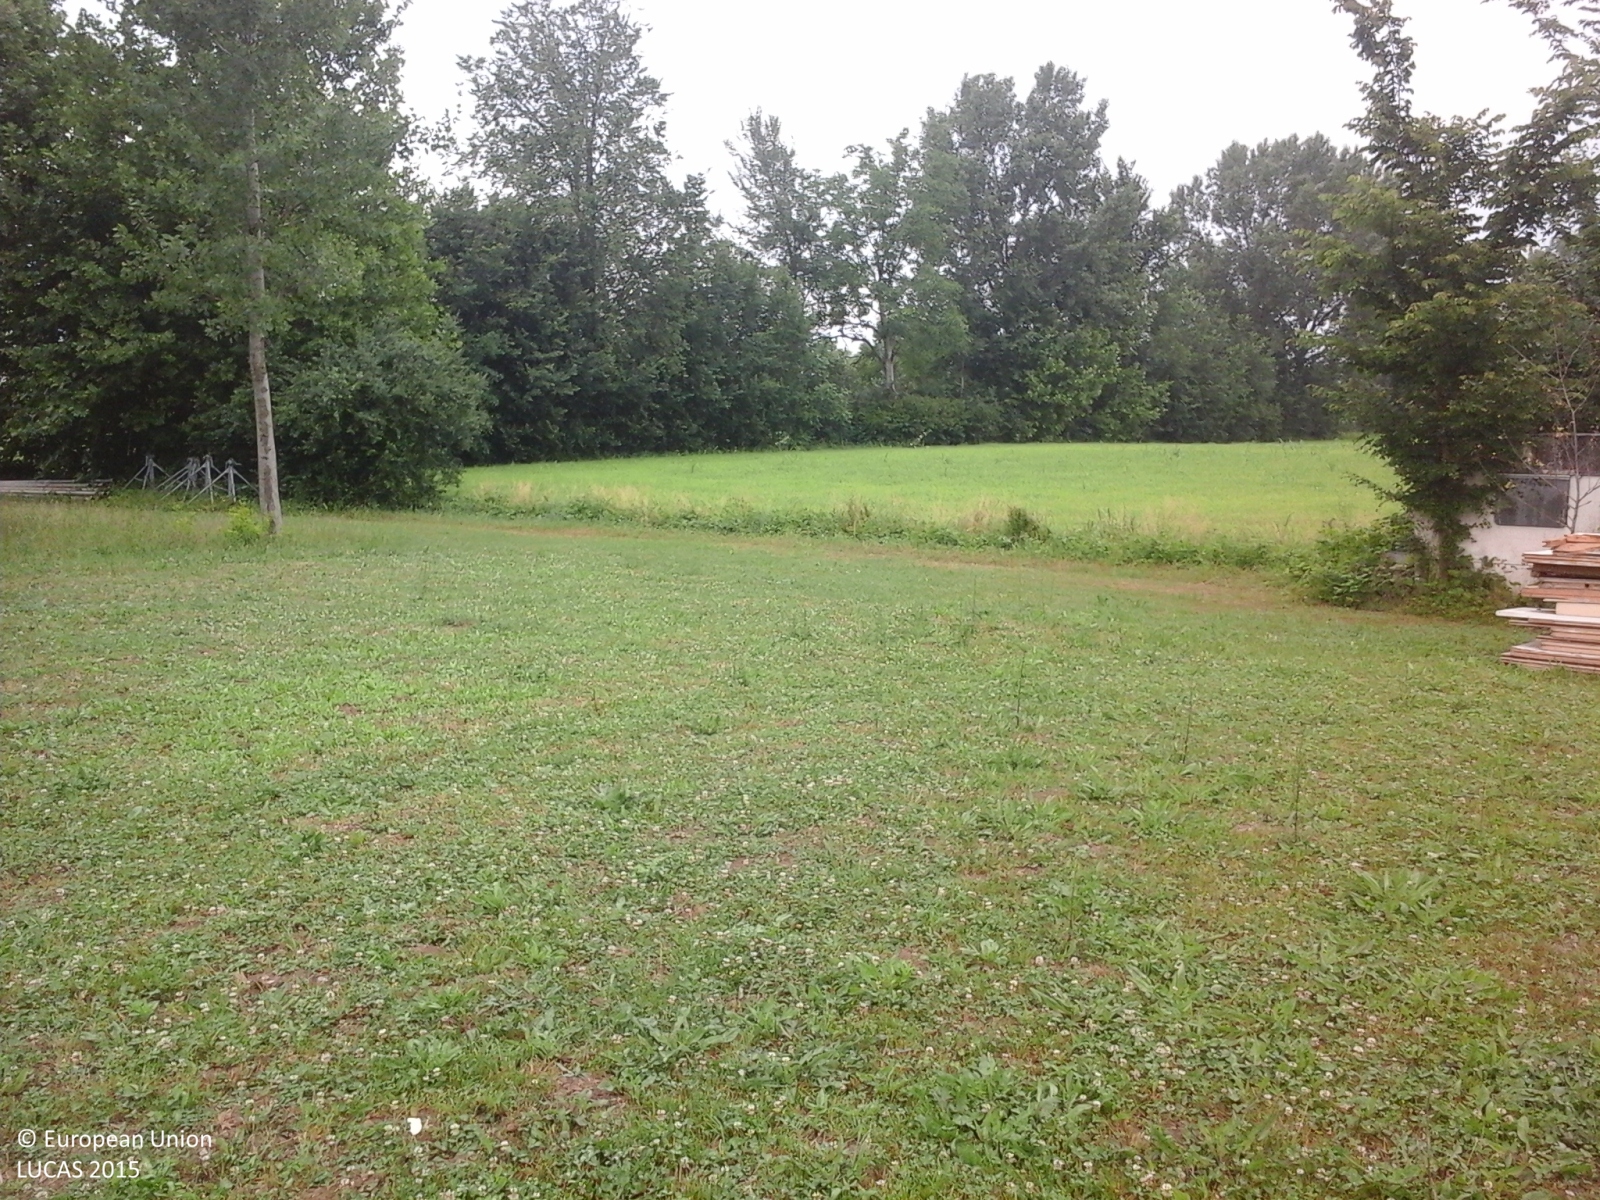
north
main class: Grassland
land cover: Grassland without tree/shrub cover
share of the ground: > 75 %
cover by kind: herbaceous plants 100 %
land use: Agriculture (excluding fallow land and kitchen gardens)
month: May
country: IT
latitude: 45.1054
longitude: 10.7231
